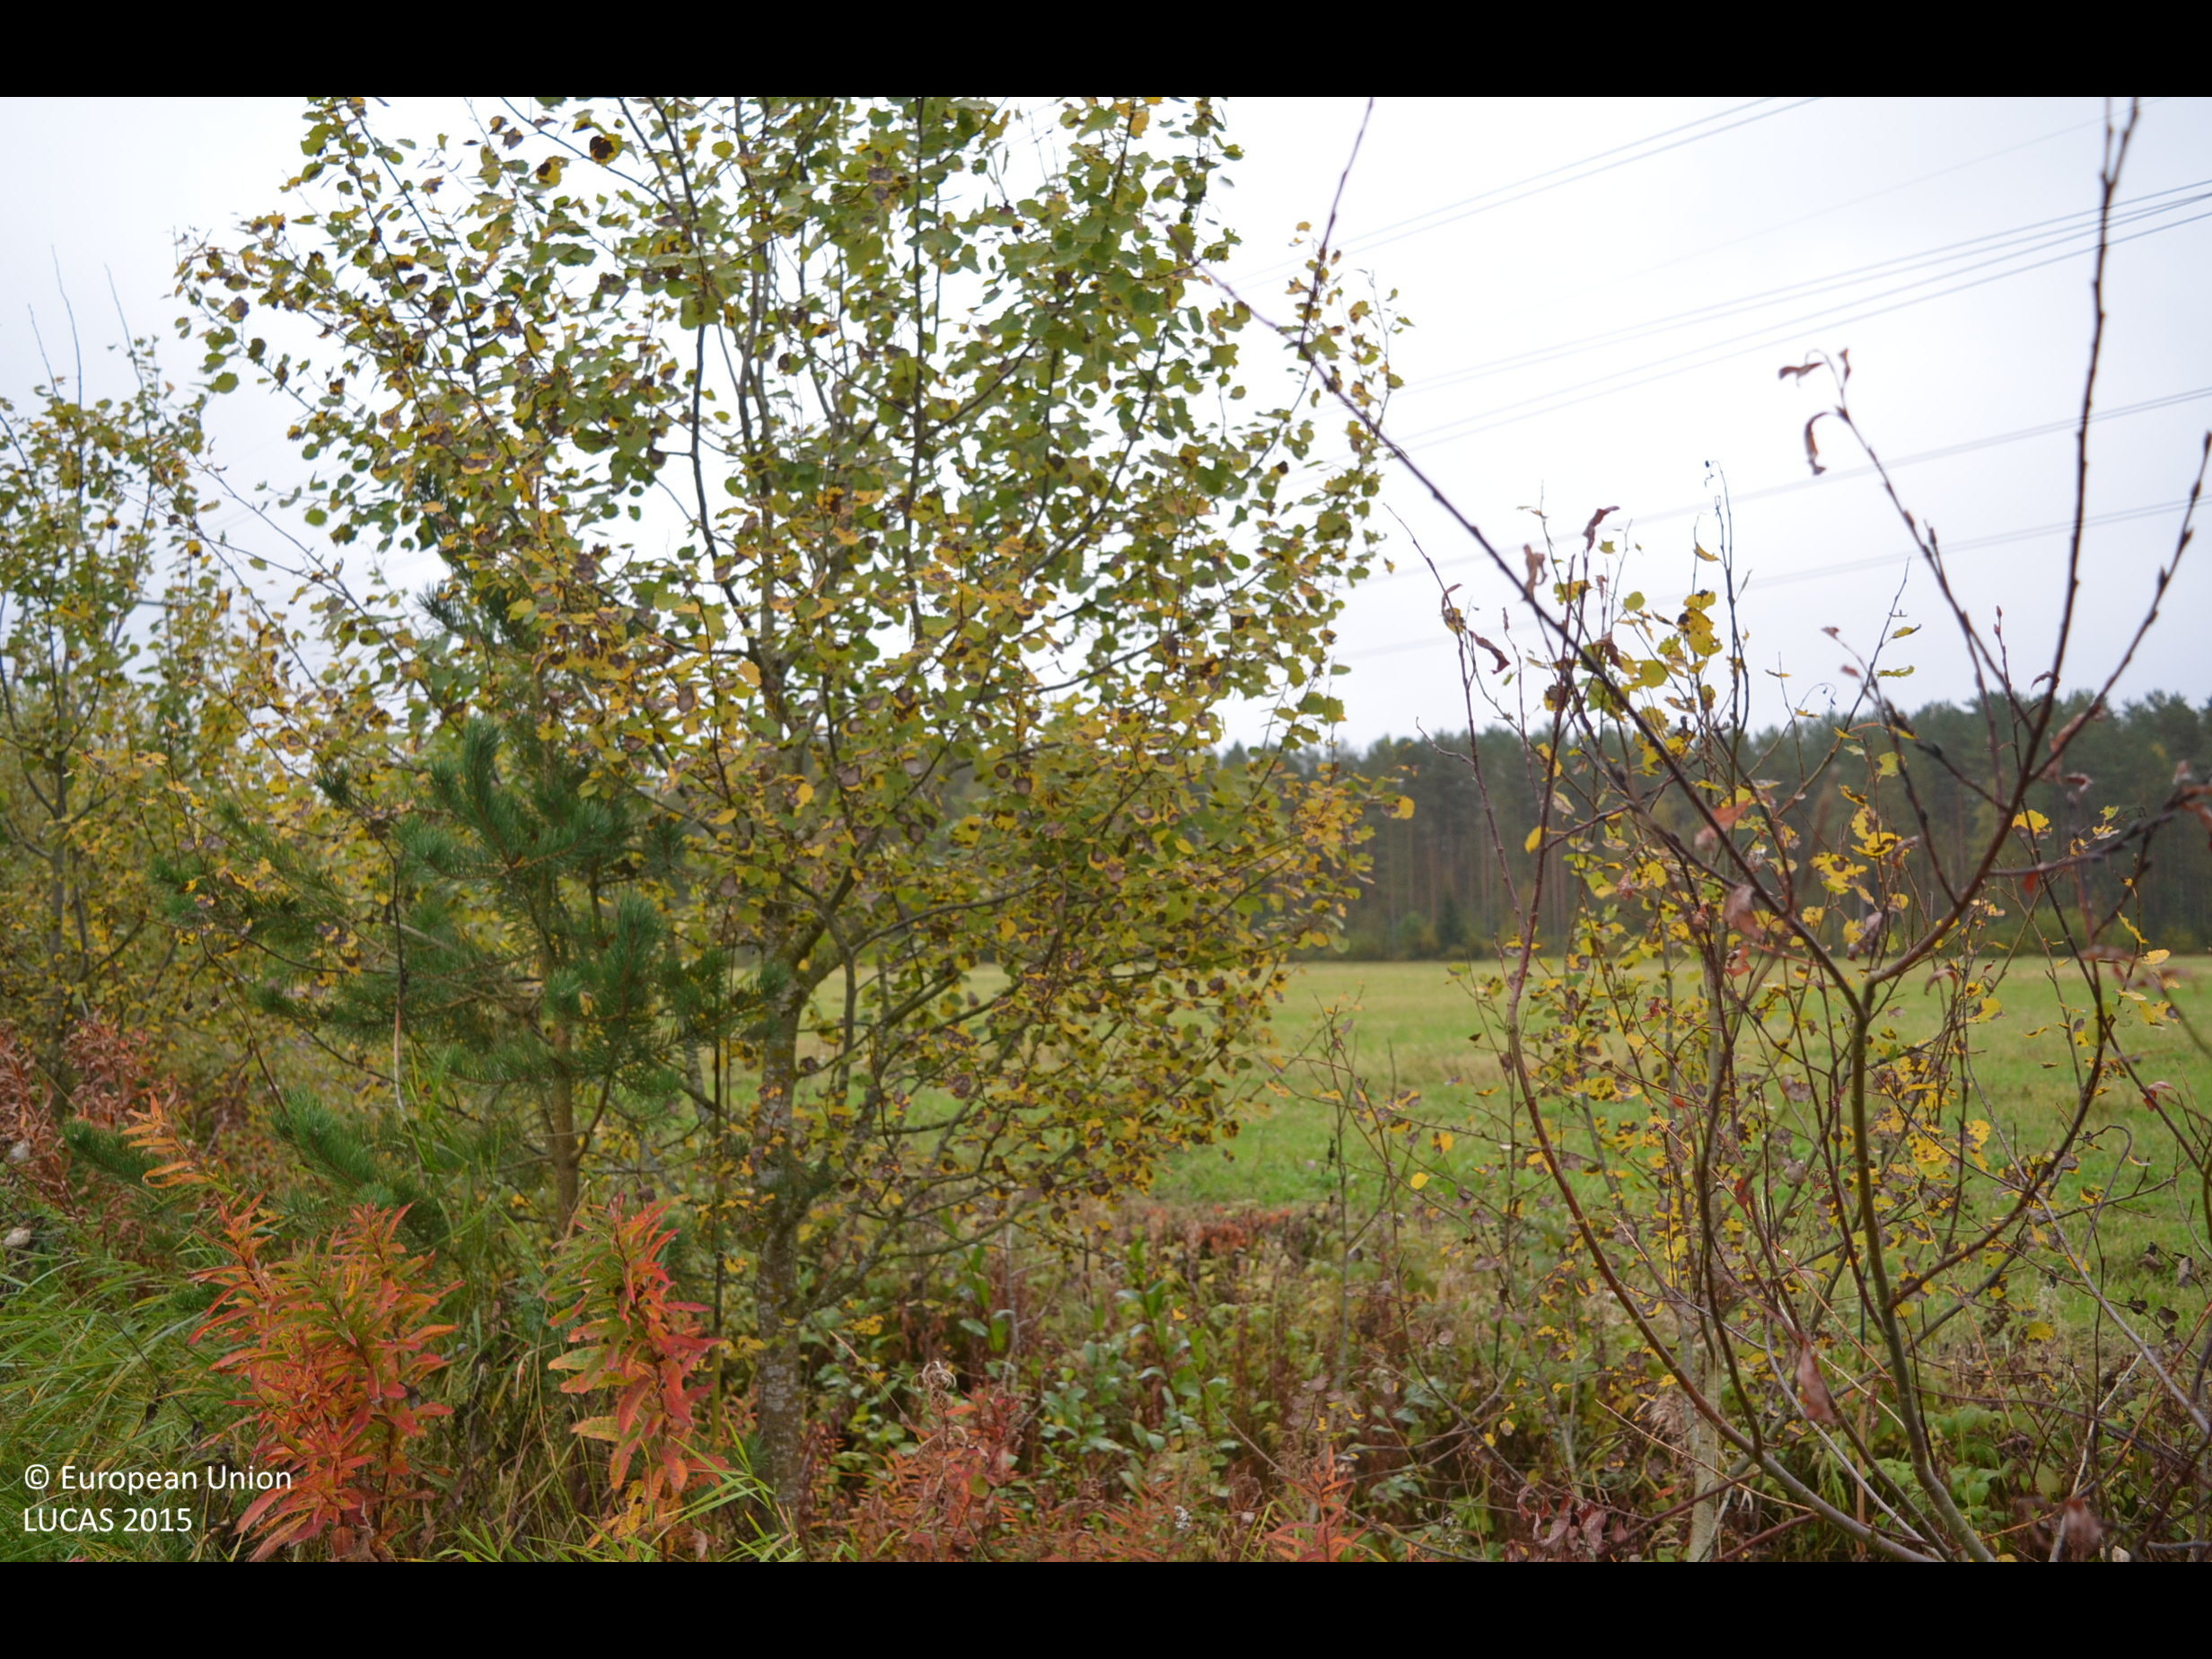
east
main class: Cropland
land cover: Temporary grasslands
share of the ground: > 75 %
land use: Agriculture (excluding fallow land and kitchen gardens)
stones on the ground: < 10 %
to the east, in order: Temporary grasslands; Shruby margins; Ditches and canals; Grass margins; Temporary grasslands; Electric lines; Temporary grasslands; Electric lines; Ditches and canals; Shrubland without tree cover; Pine dominated mixed woodland; Pine dominated coniferous woodland; Other mixed woodland
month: September
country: FI
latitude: 62.9347
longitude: 23.7229
